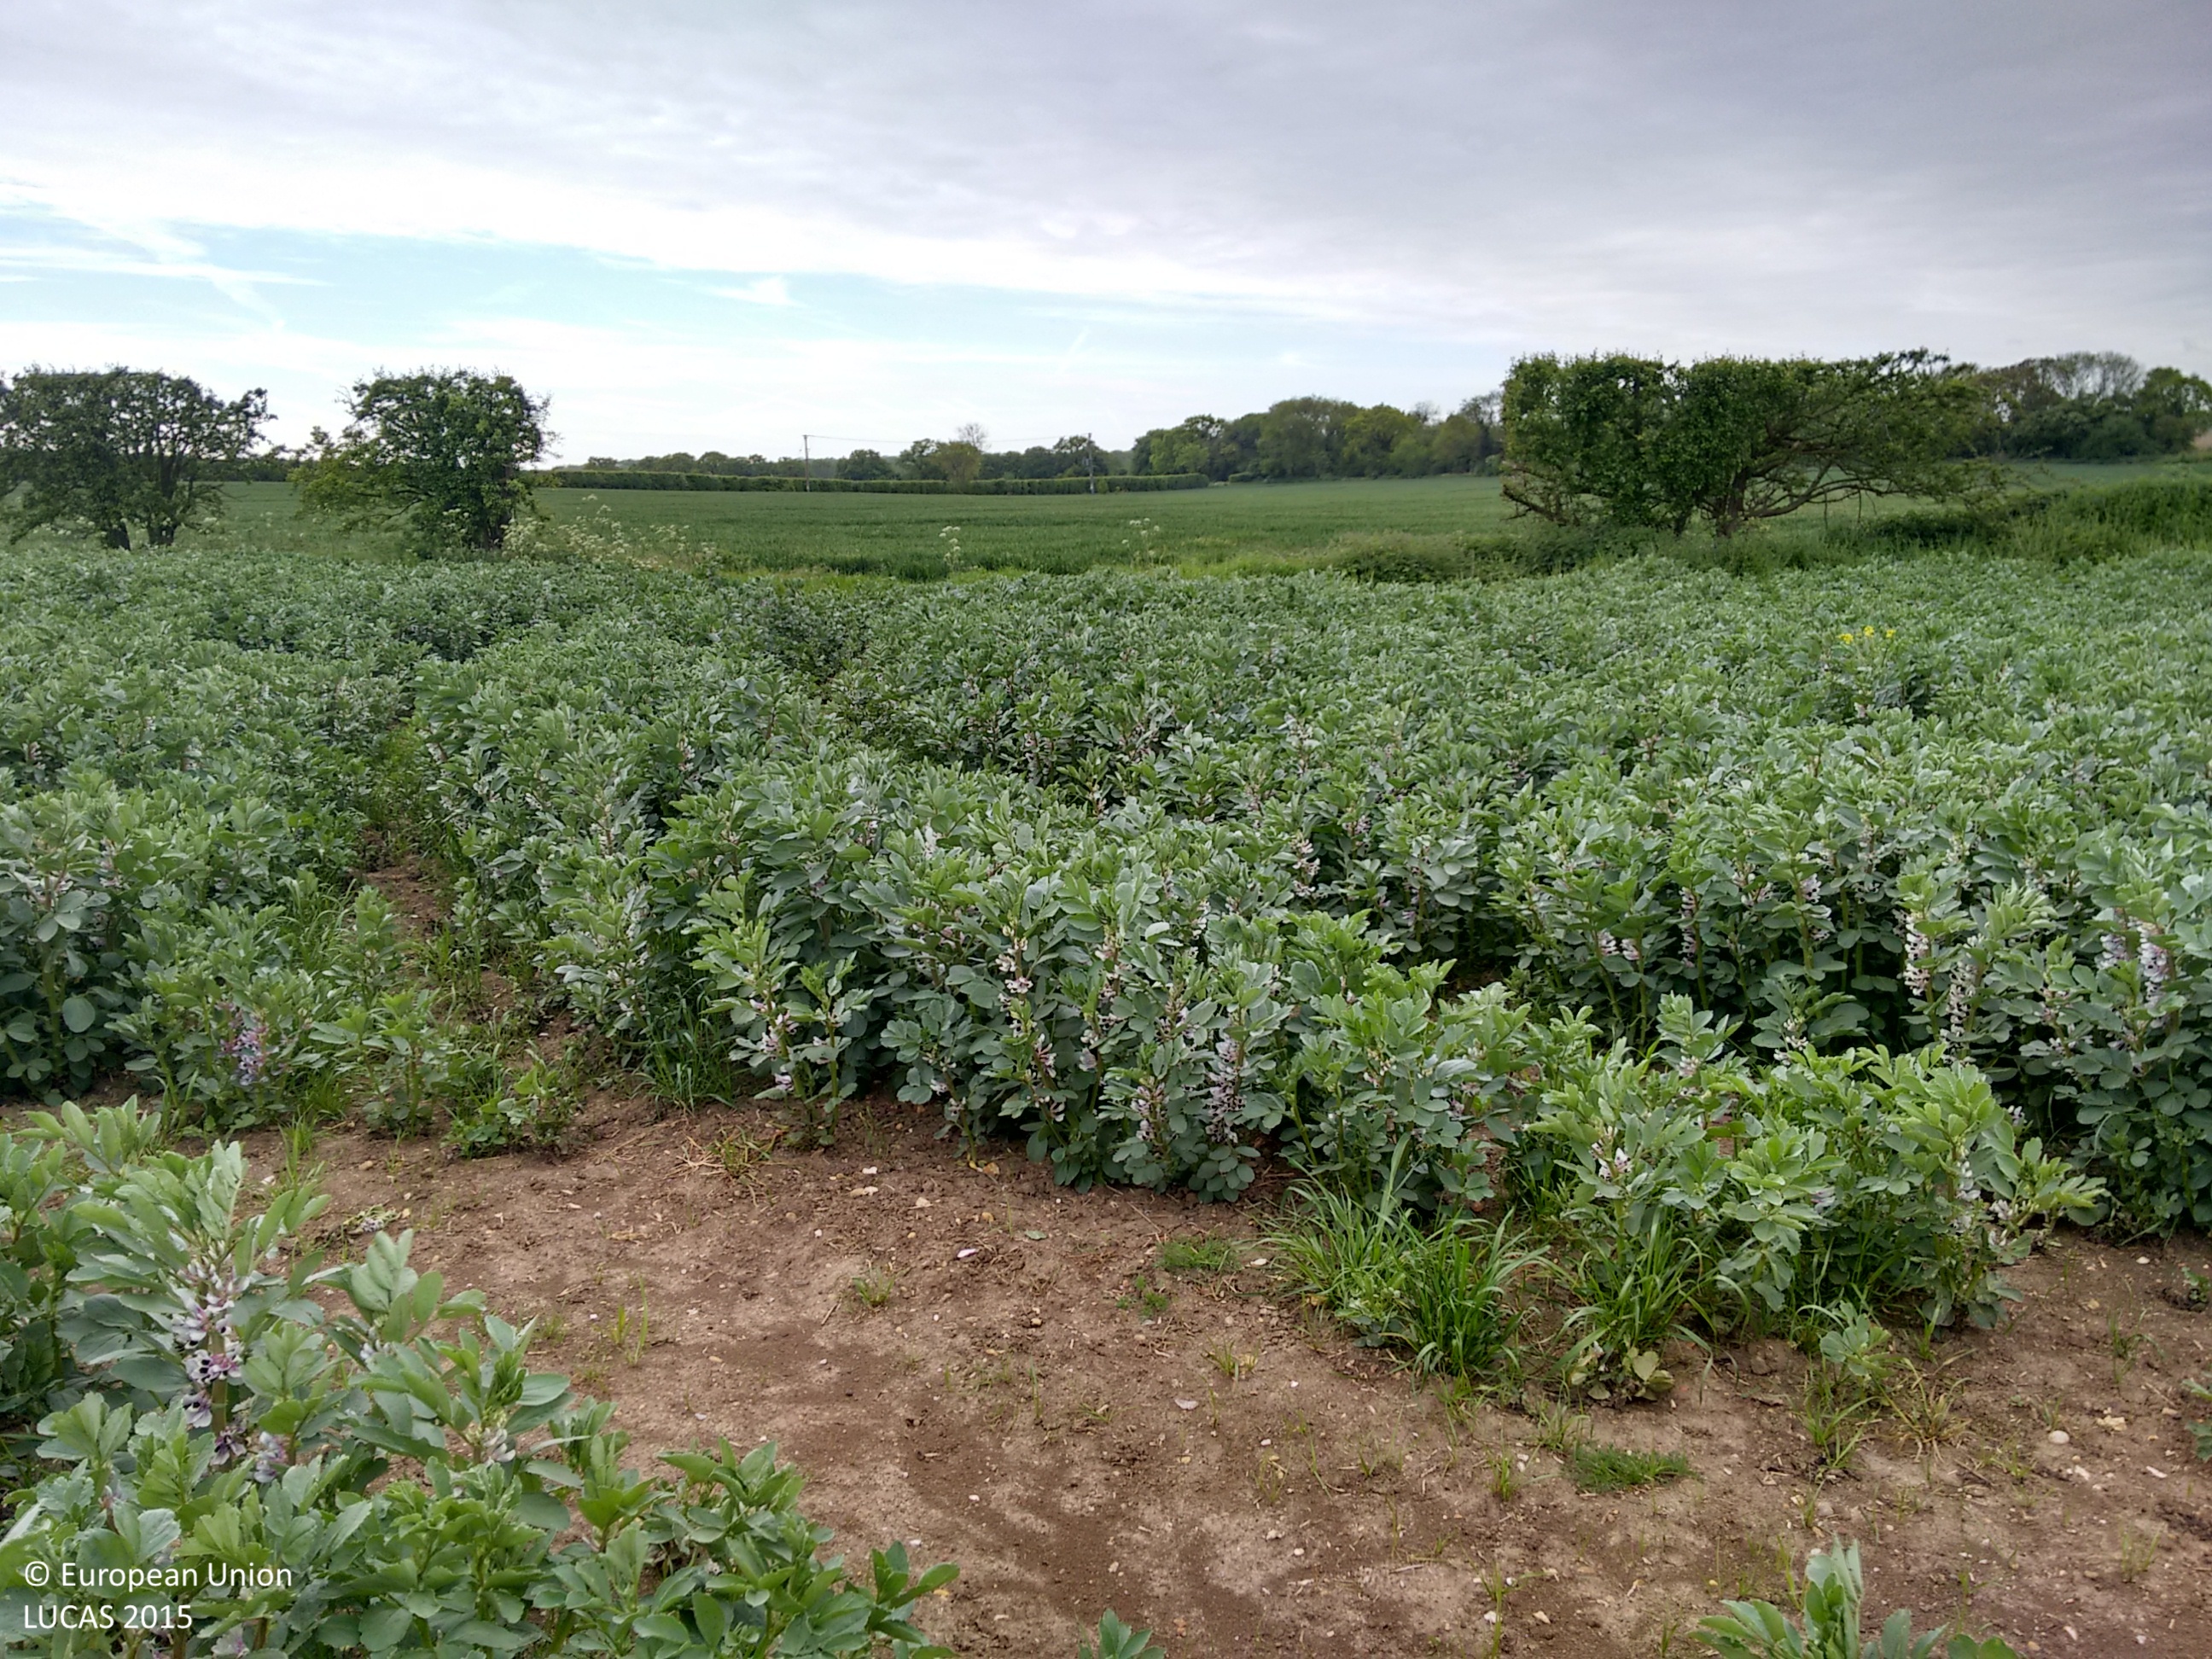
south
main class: Cropland
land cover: Dry pulses
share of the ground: > 75 %
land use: Agriculture (excluding fallow land and kitchen gardens)
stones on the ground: 10 - 25 %
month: May
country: GB
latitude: 51.3972
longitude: 0.2680
